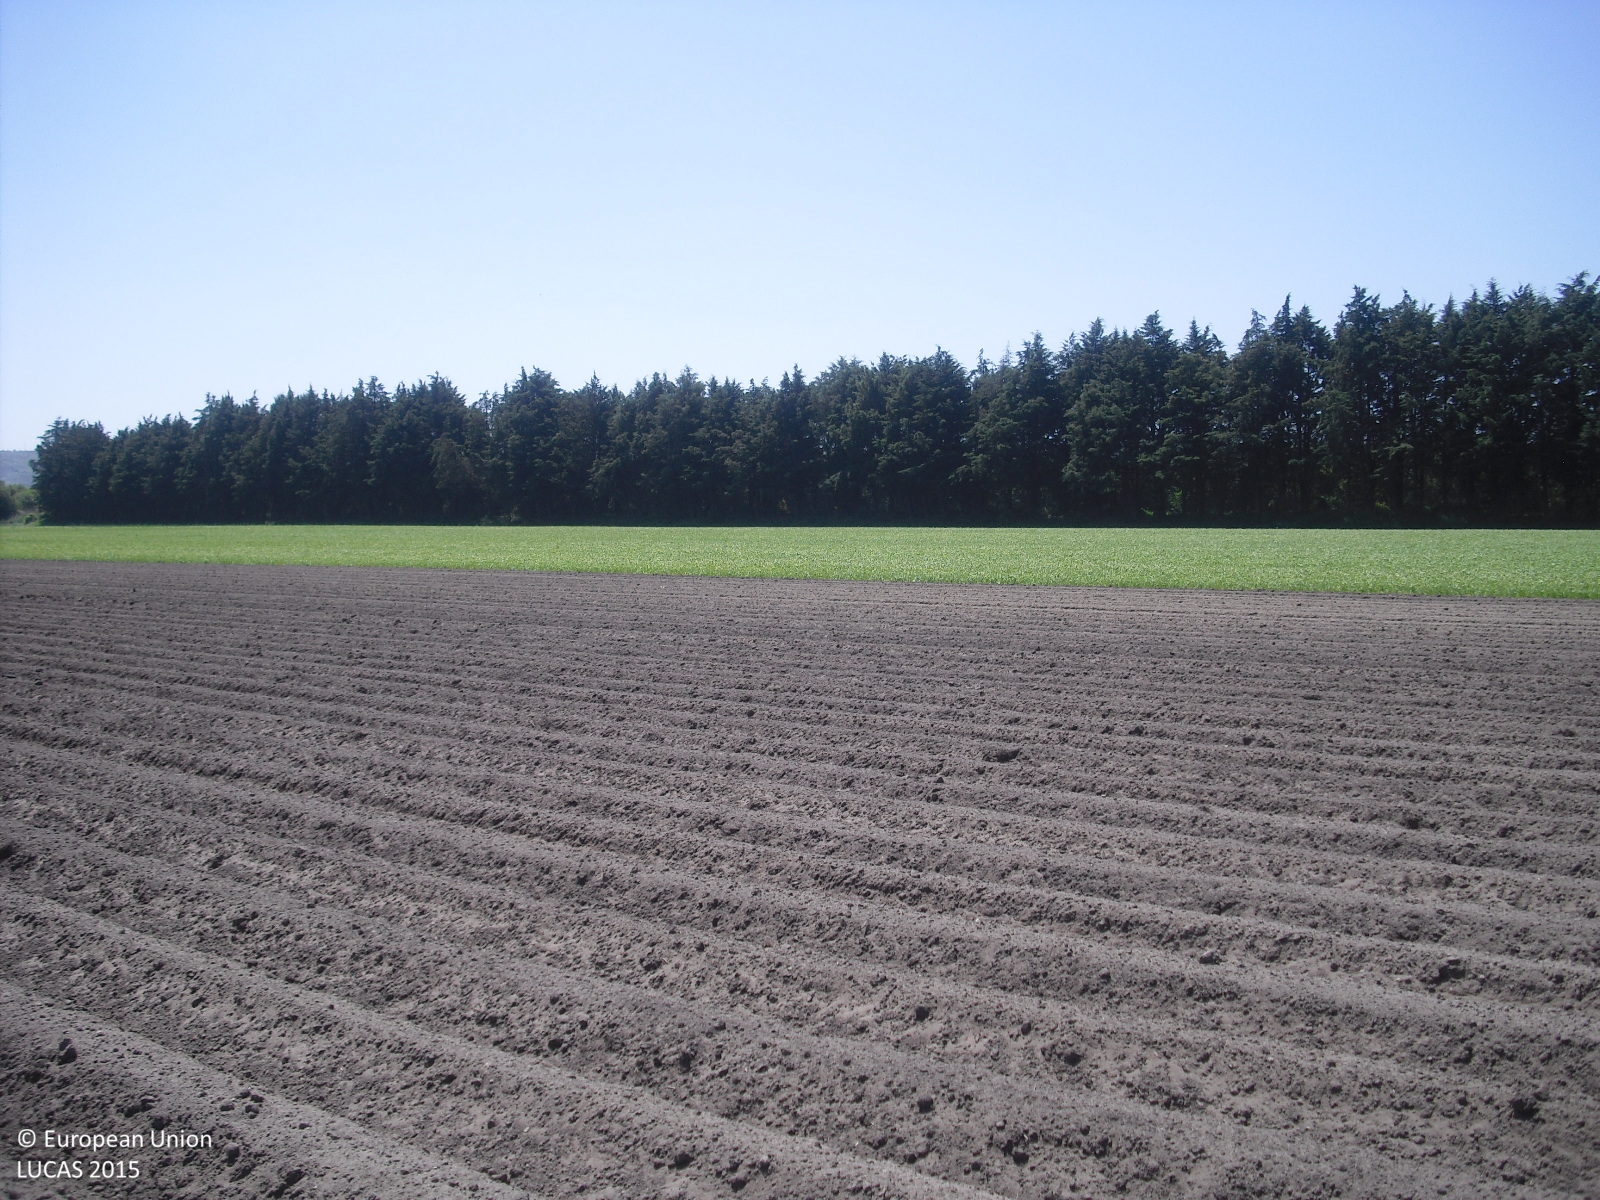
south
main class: Cropland
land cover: Potatoes
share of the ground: < 10 %
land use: Agriculture (excluding fallow land and kitchen gardens)
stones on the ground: < 10 %
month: May
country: ES
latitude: 42.1150
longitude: -7.6910
